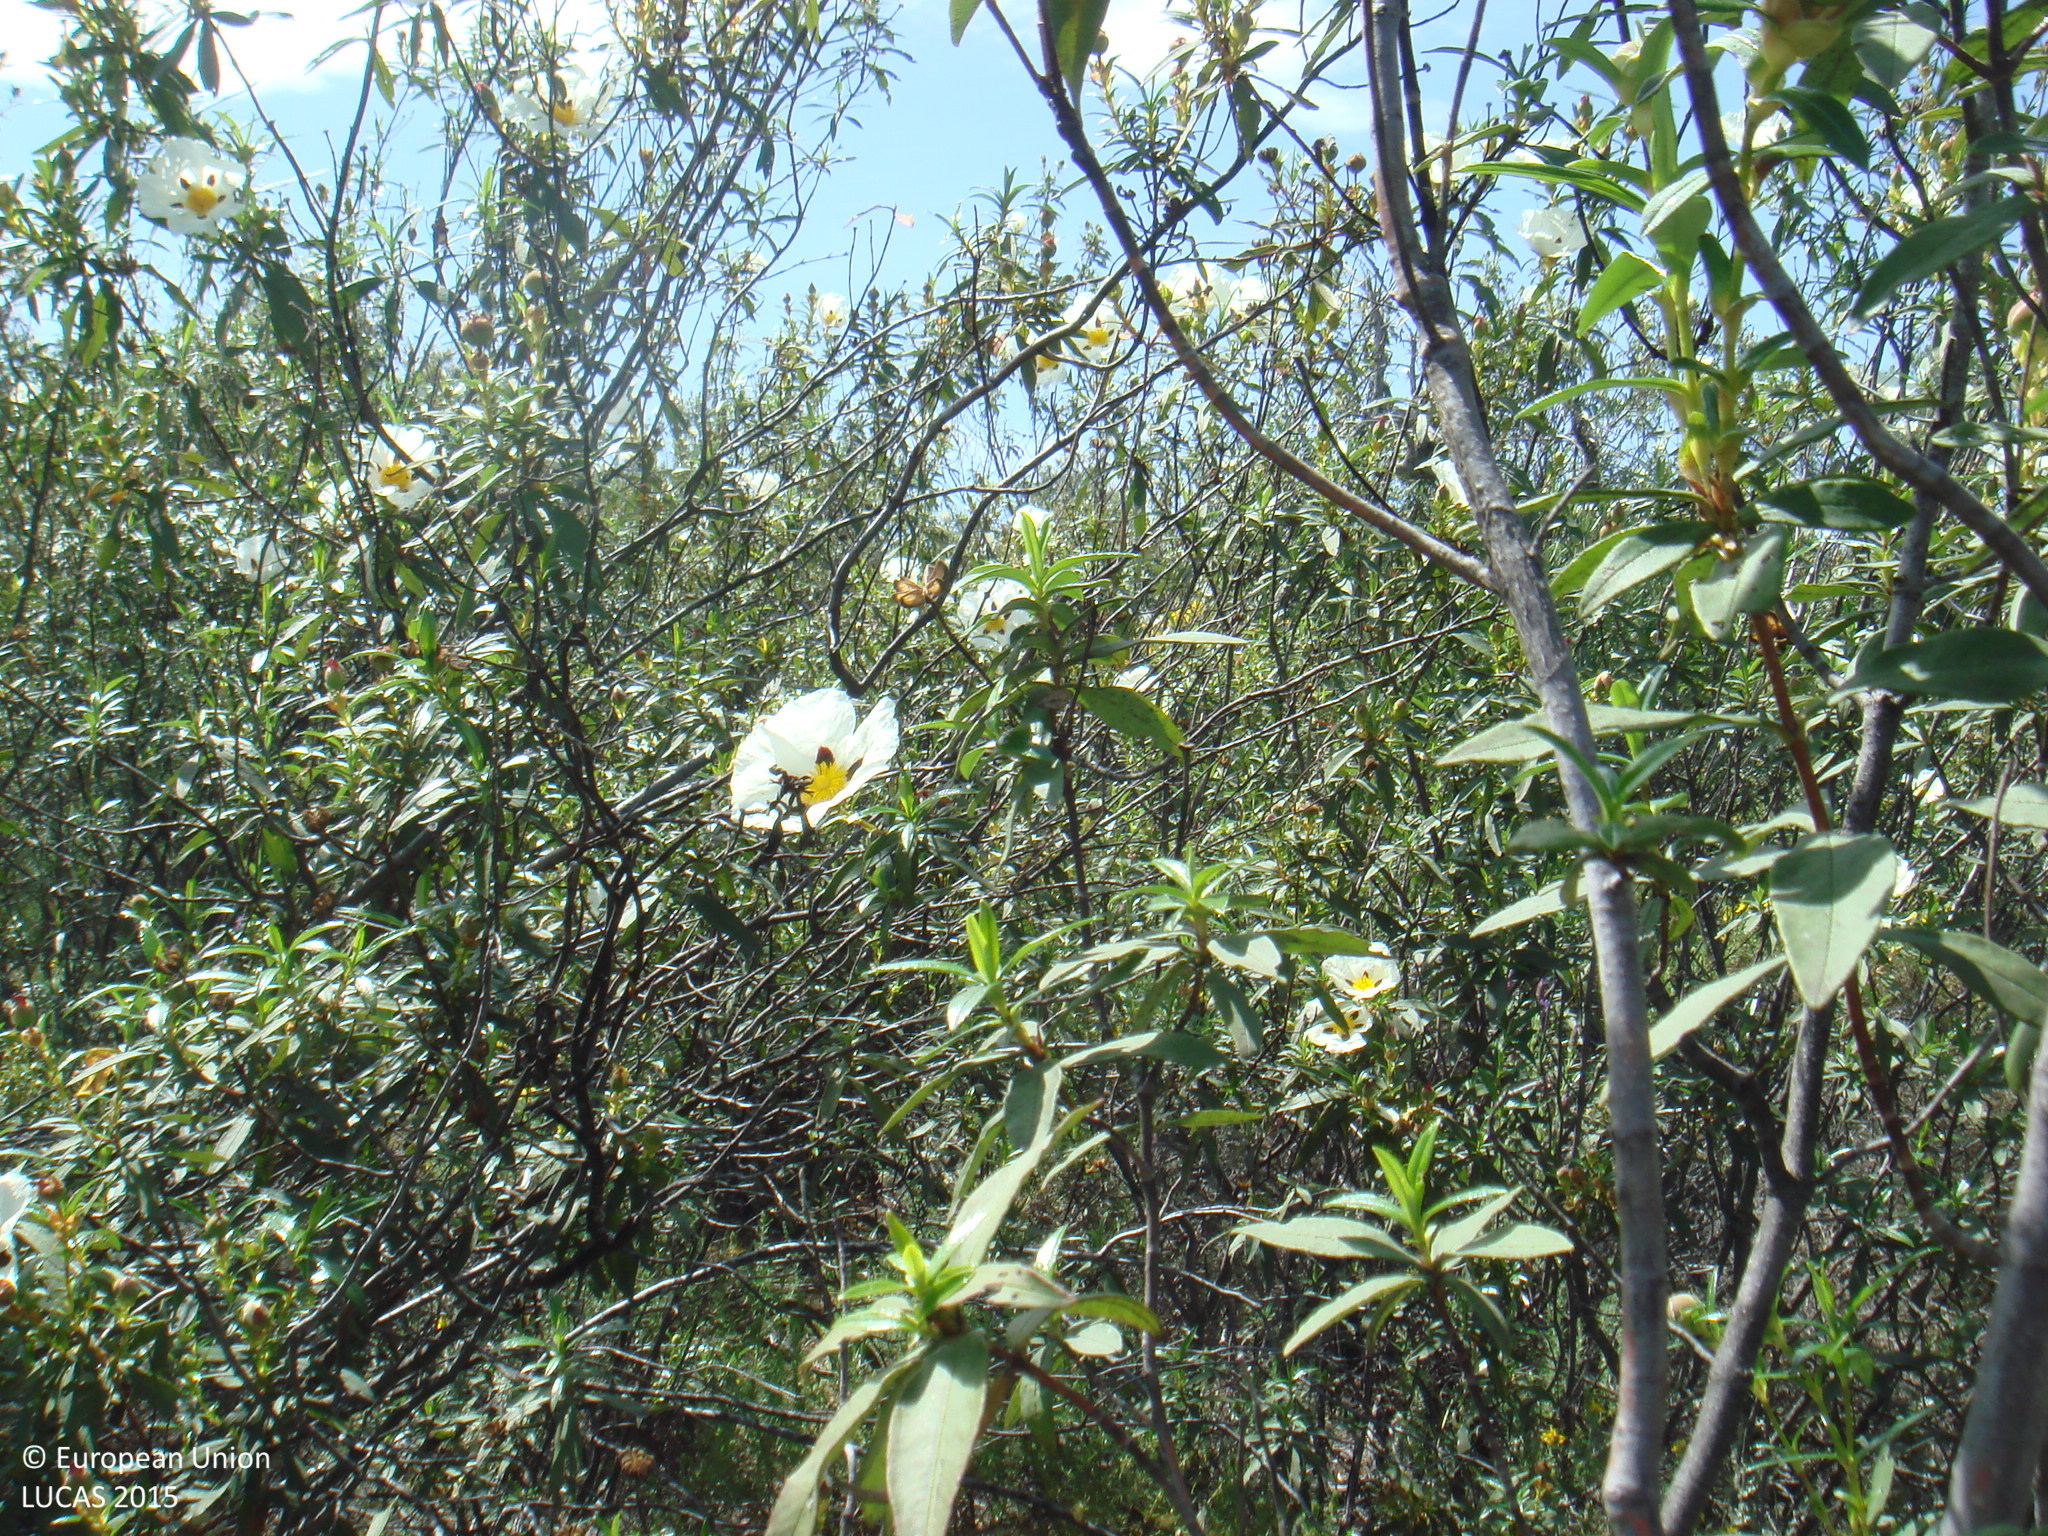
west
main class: Shrubland
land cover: Shrubland with sparse tree cover
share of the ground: > 75 %
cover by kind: shrubs 85 %, herbaceous plants 10 %, broadleaved forest trees 5 %
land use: Forestry
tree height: > 5 m
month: May
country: ES
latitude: 38.3101
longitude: -5.0411
